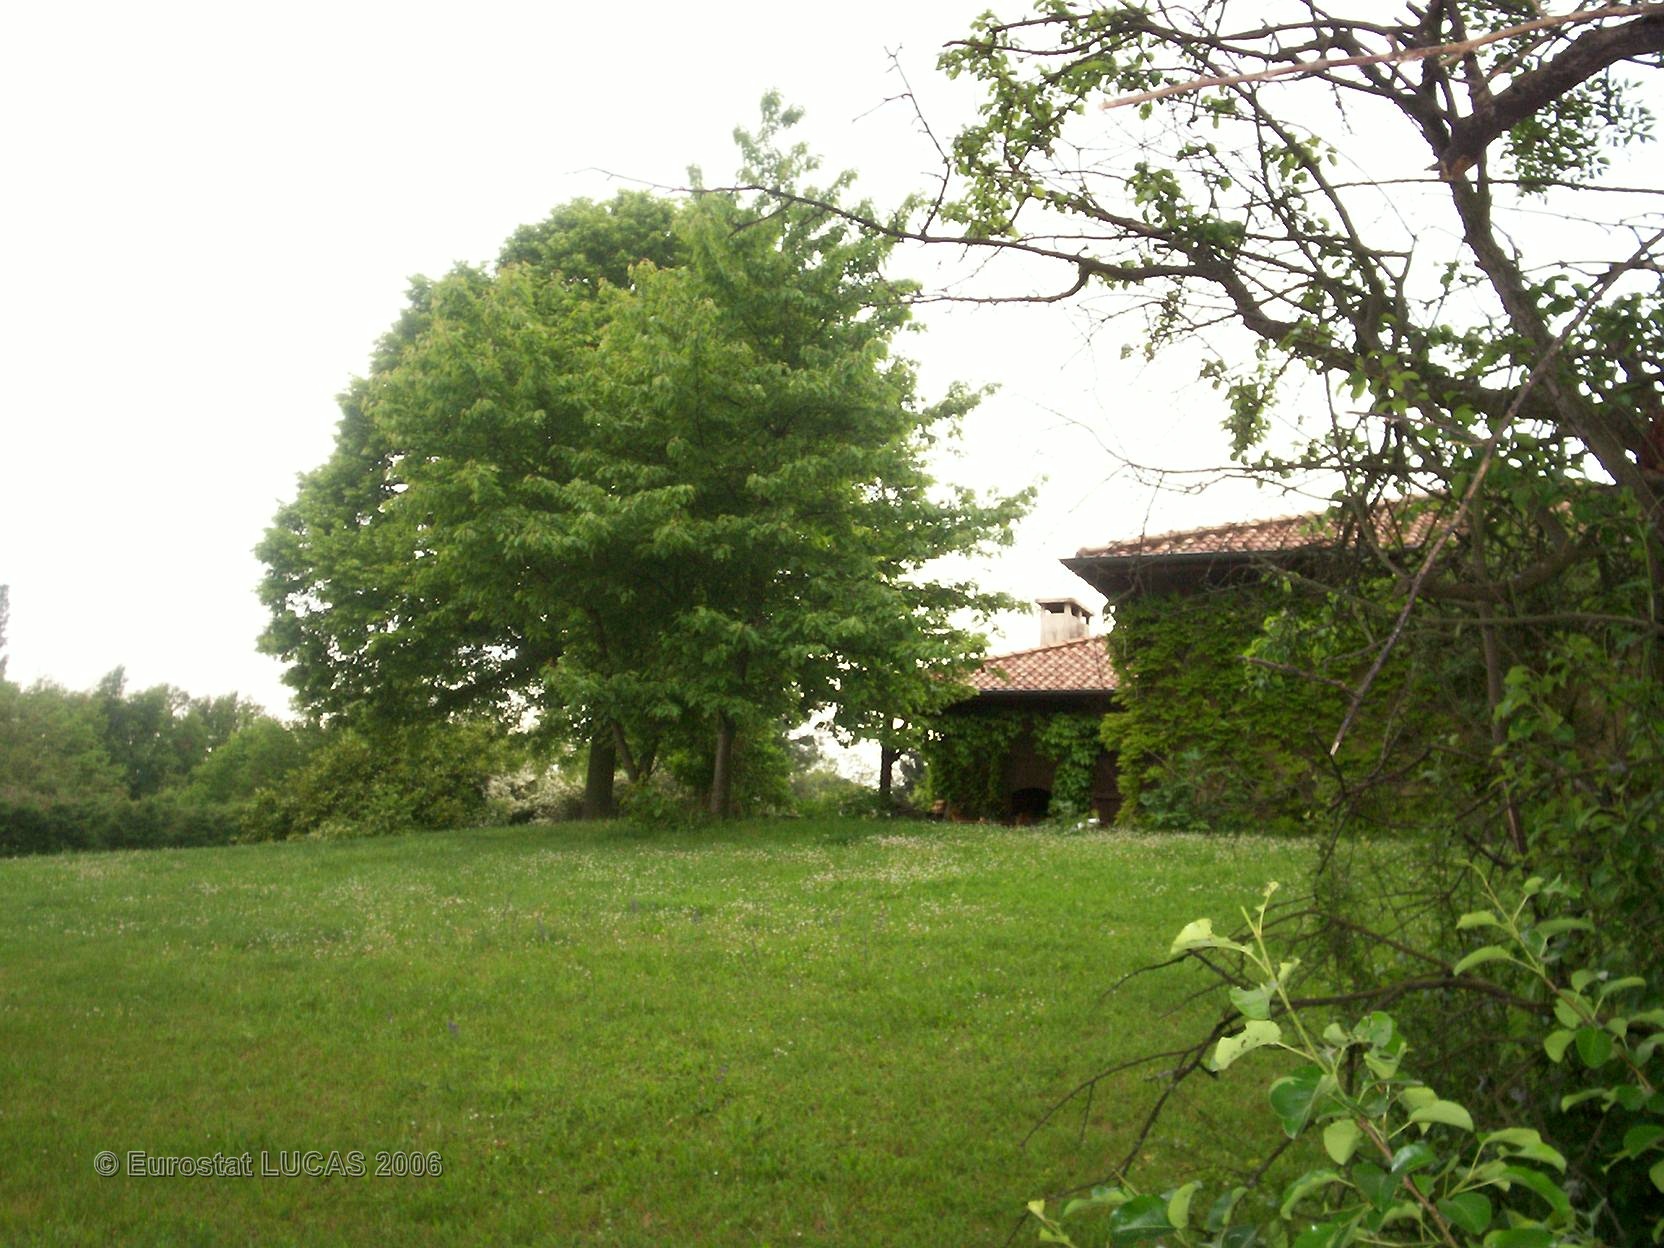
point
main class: Grassland
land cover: Grassland with sparse tree/shrub cover
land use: Residential
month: May
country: FR
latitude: 45.8067
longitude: 4.7404
